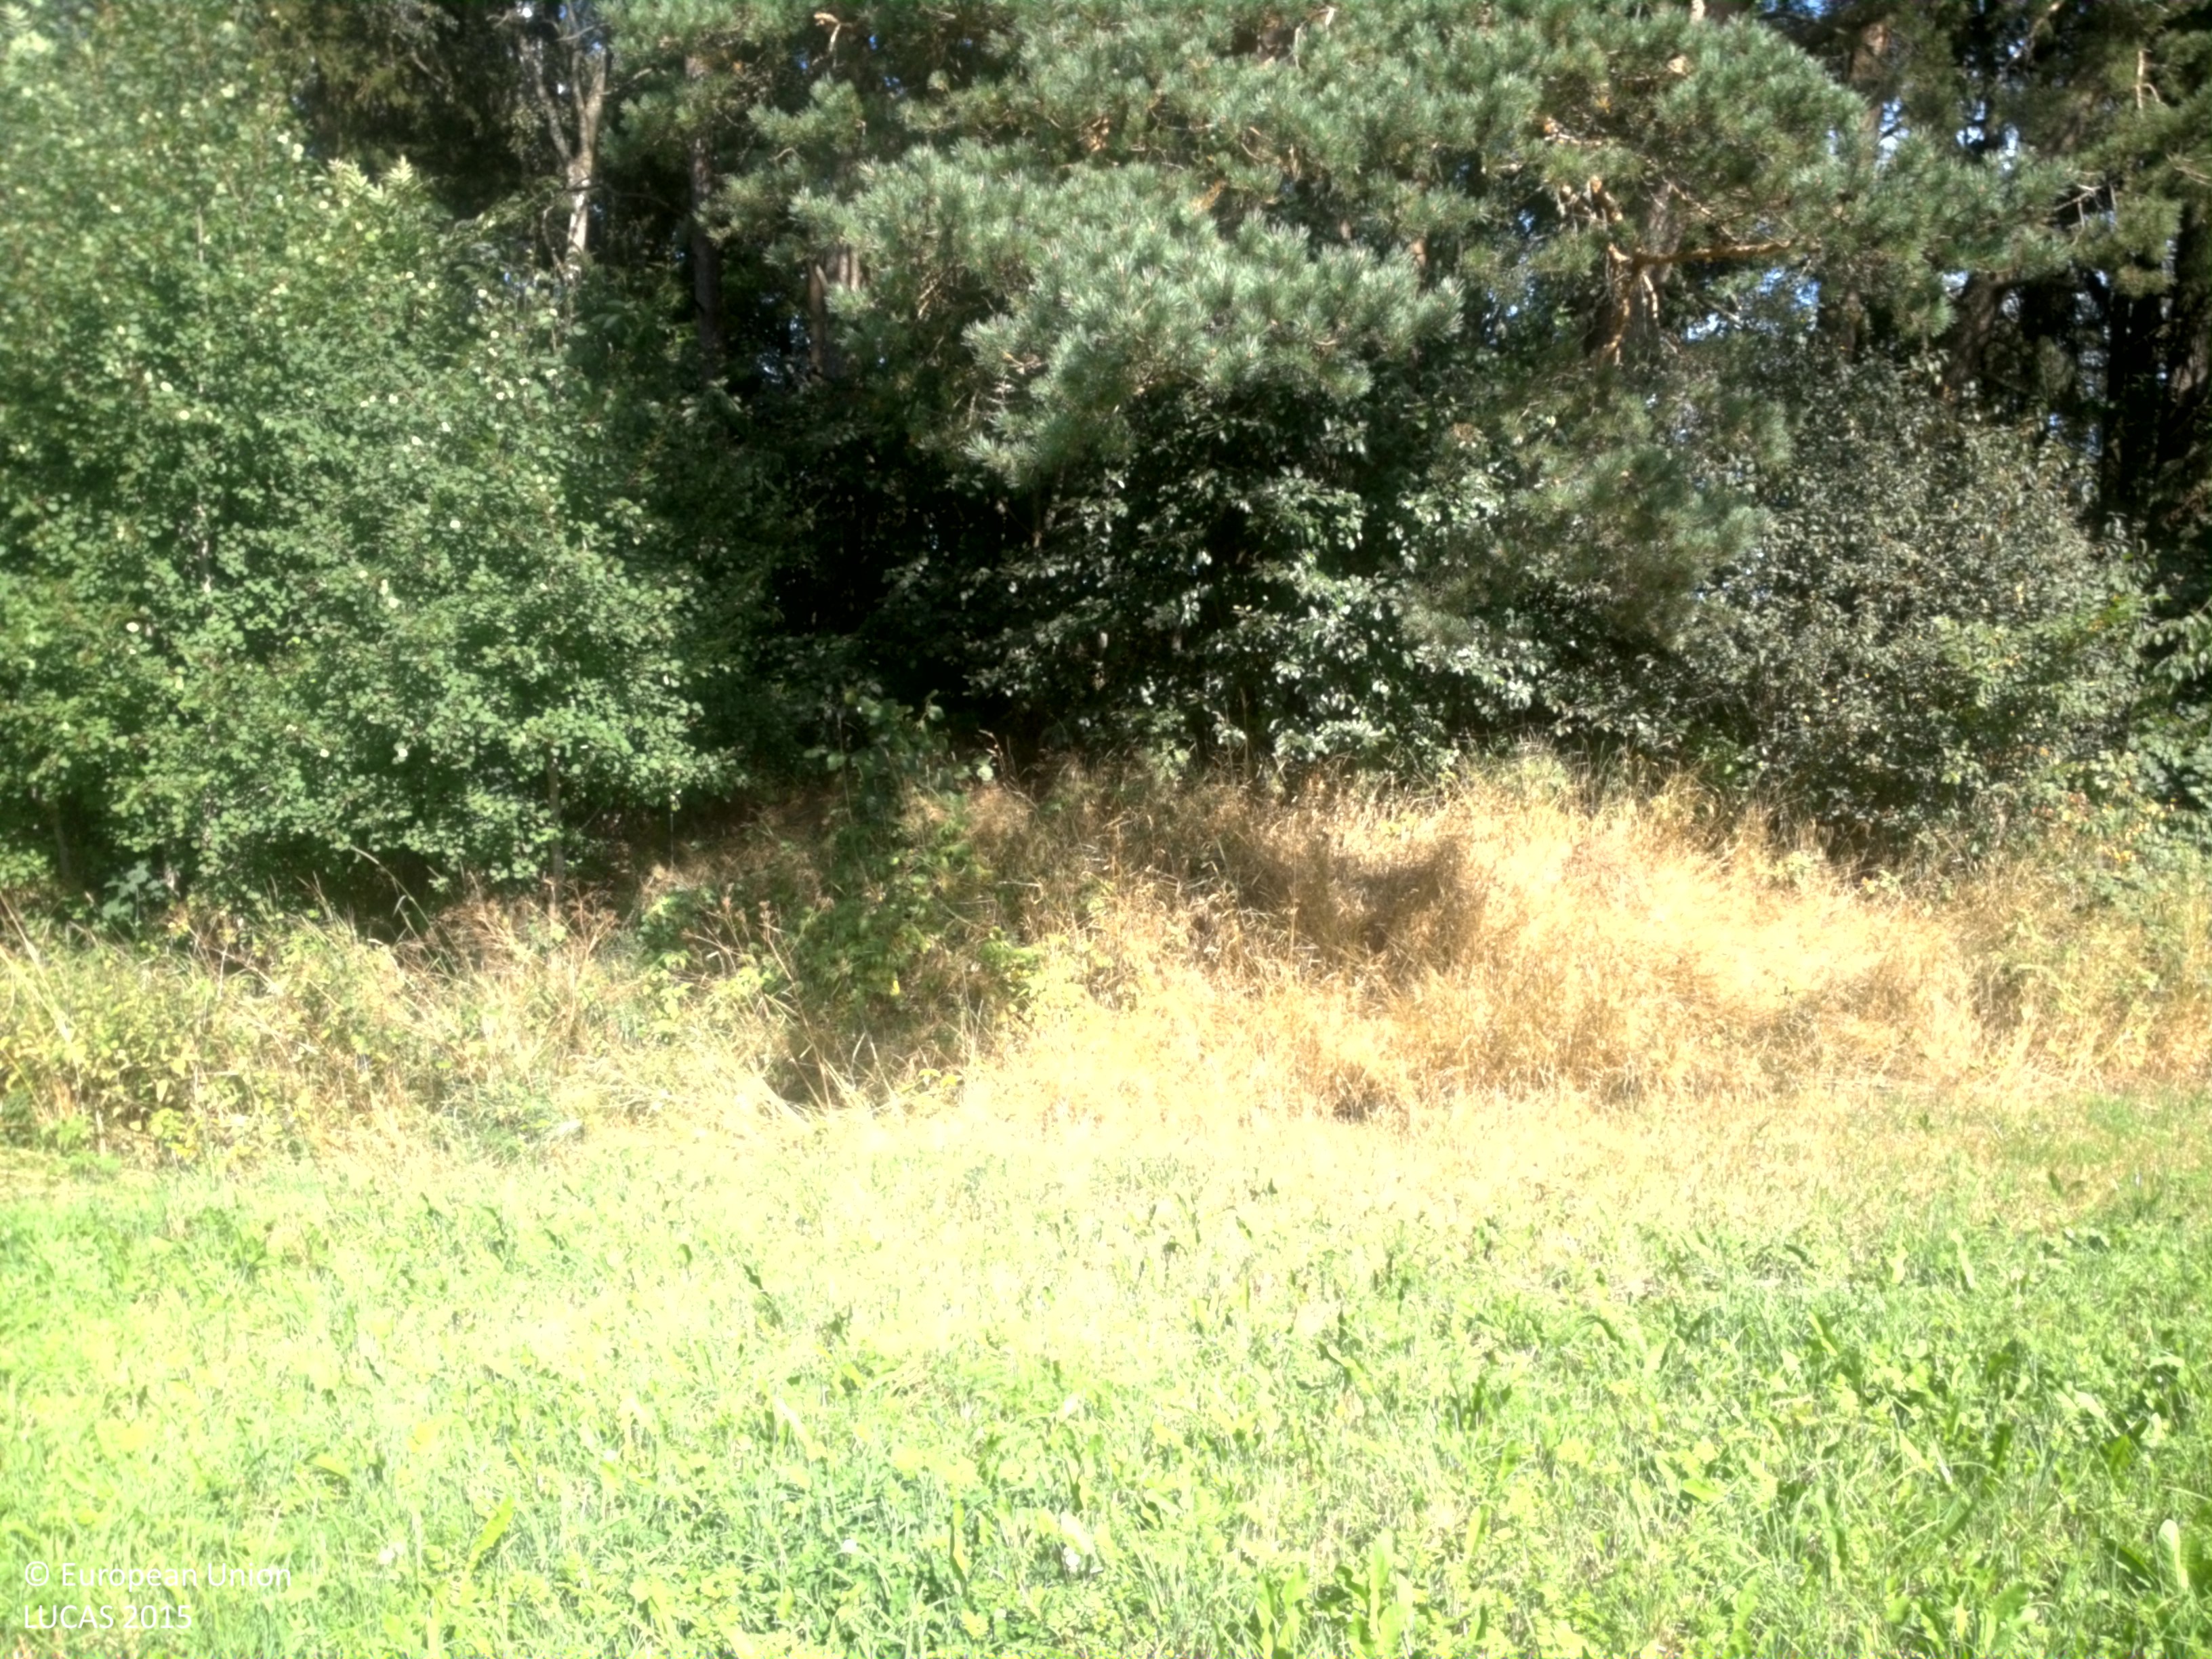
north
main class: Grassland
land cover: Grassland without tree/shrub cover
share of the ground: > 75 %
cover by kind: herbaceous plants 100 %
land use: Agriculture (excluding fallow land and kitchen gardens)
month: August
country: SE
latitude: 58.1078
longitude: 13.2700
